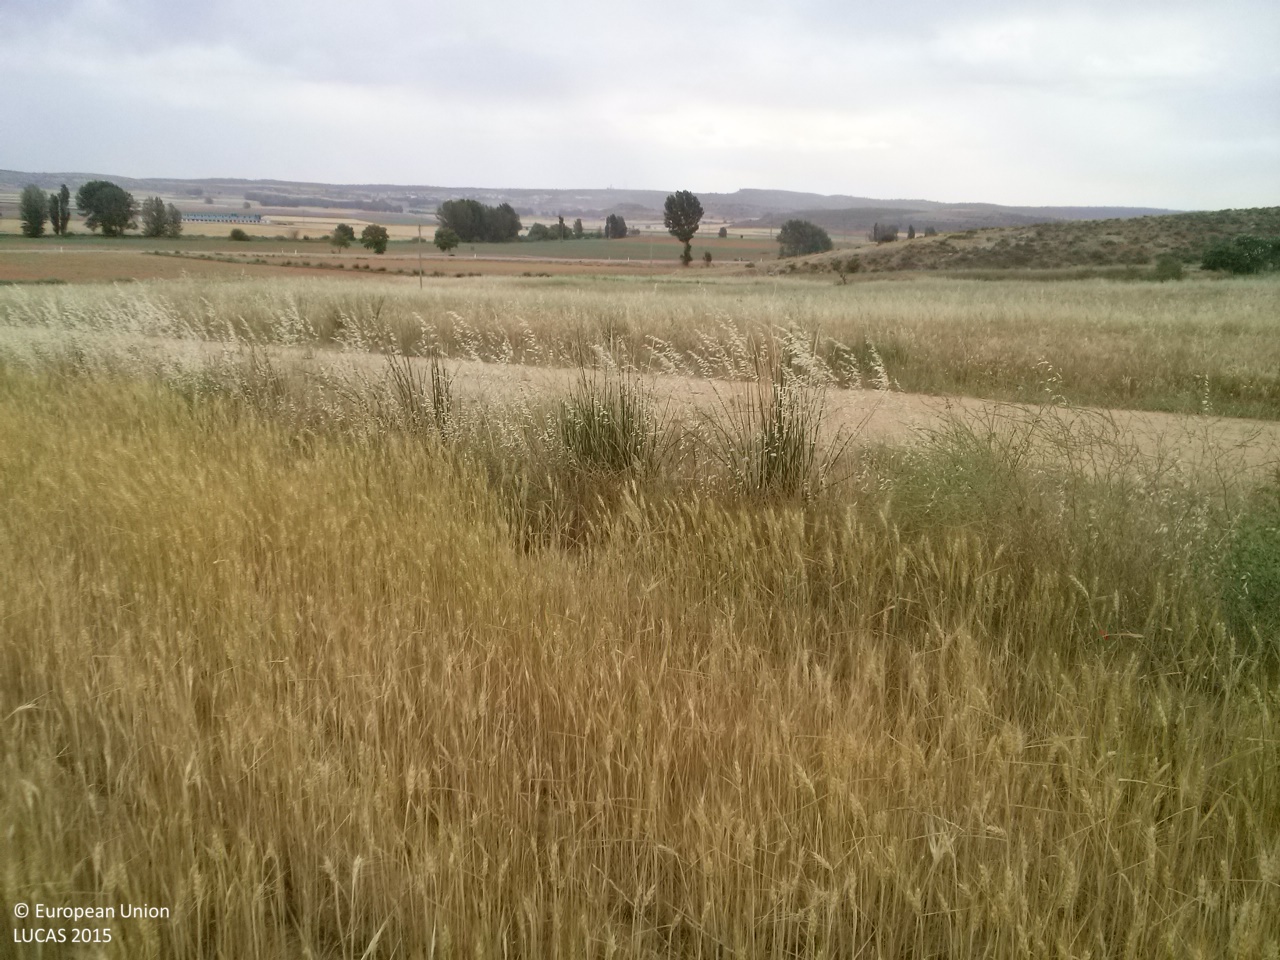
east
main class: Cropland
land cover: Barley
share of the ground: > 75 %
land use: Agriculture (excluding fallow land and kitchen gardens)
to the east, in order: Barley; Grass margins; Tracks; Grass margins; Spontaneously vegetated surfaces; Electric lines; Spontaneously vegetated surfaces; Grass margins; Dry stone walls; Grass margins; Spontaneously vegetated surfaces
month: June
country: ES
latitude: 39.9104
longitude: -1.8616
